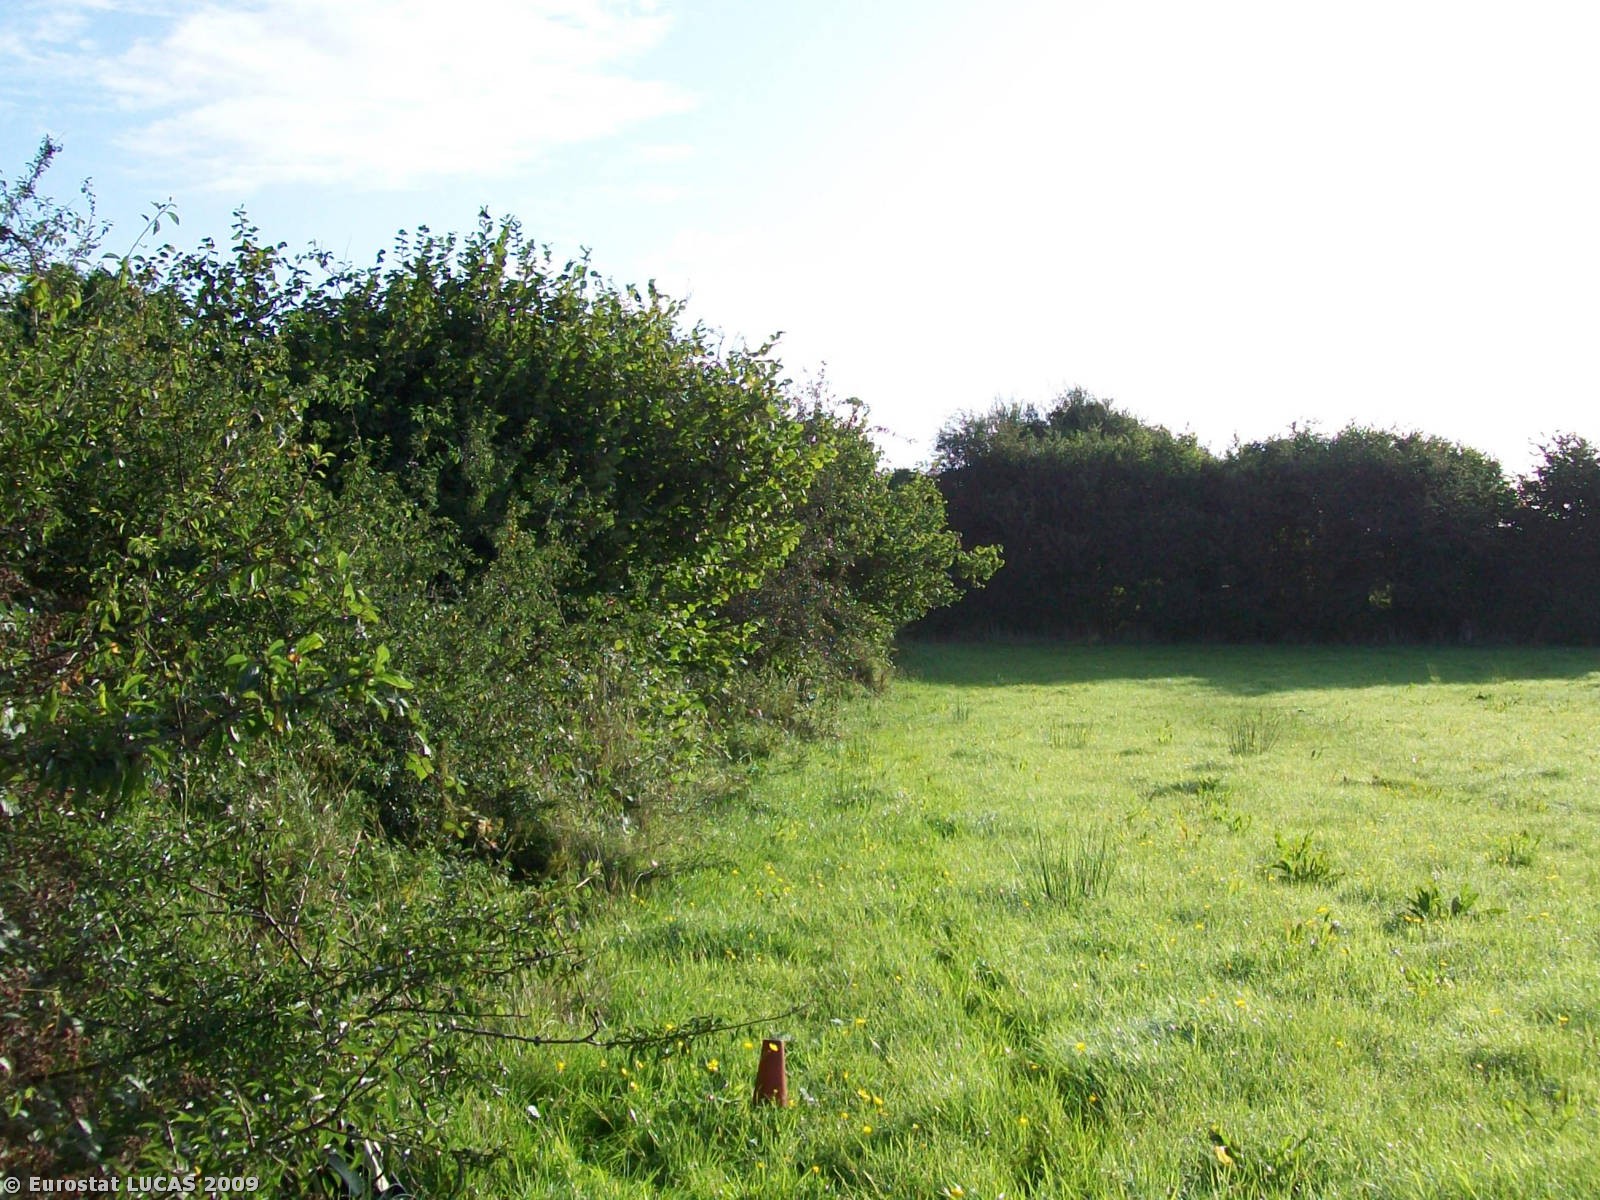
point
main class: Grassland
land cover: Grassland without tree/shrub cover
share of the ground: > 75 %
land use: Agriculture (excluding fallow land and kitchen gardens)
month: August
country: IE
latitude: 53.2283
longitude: -8.7635
